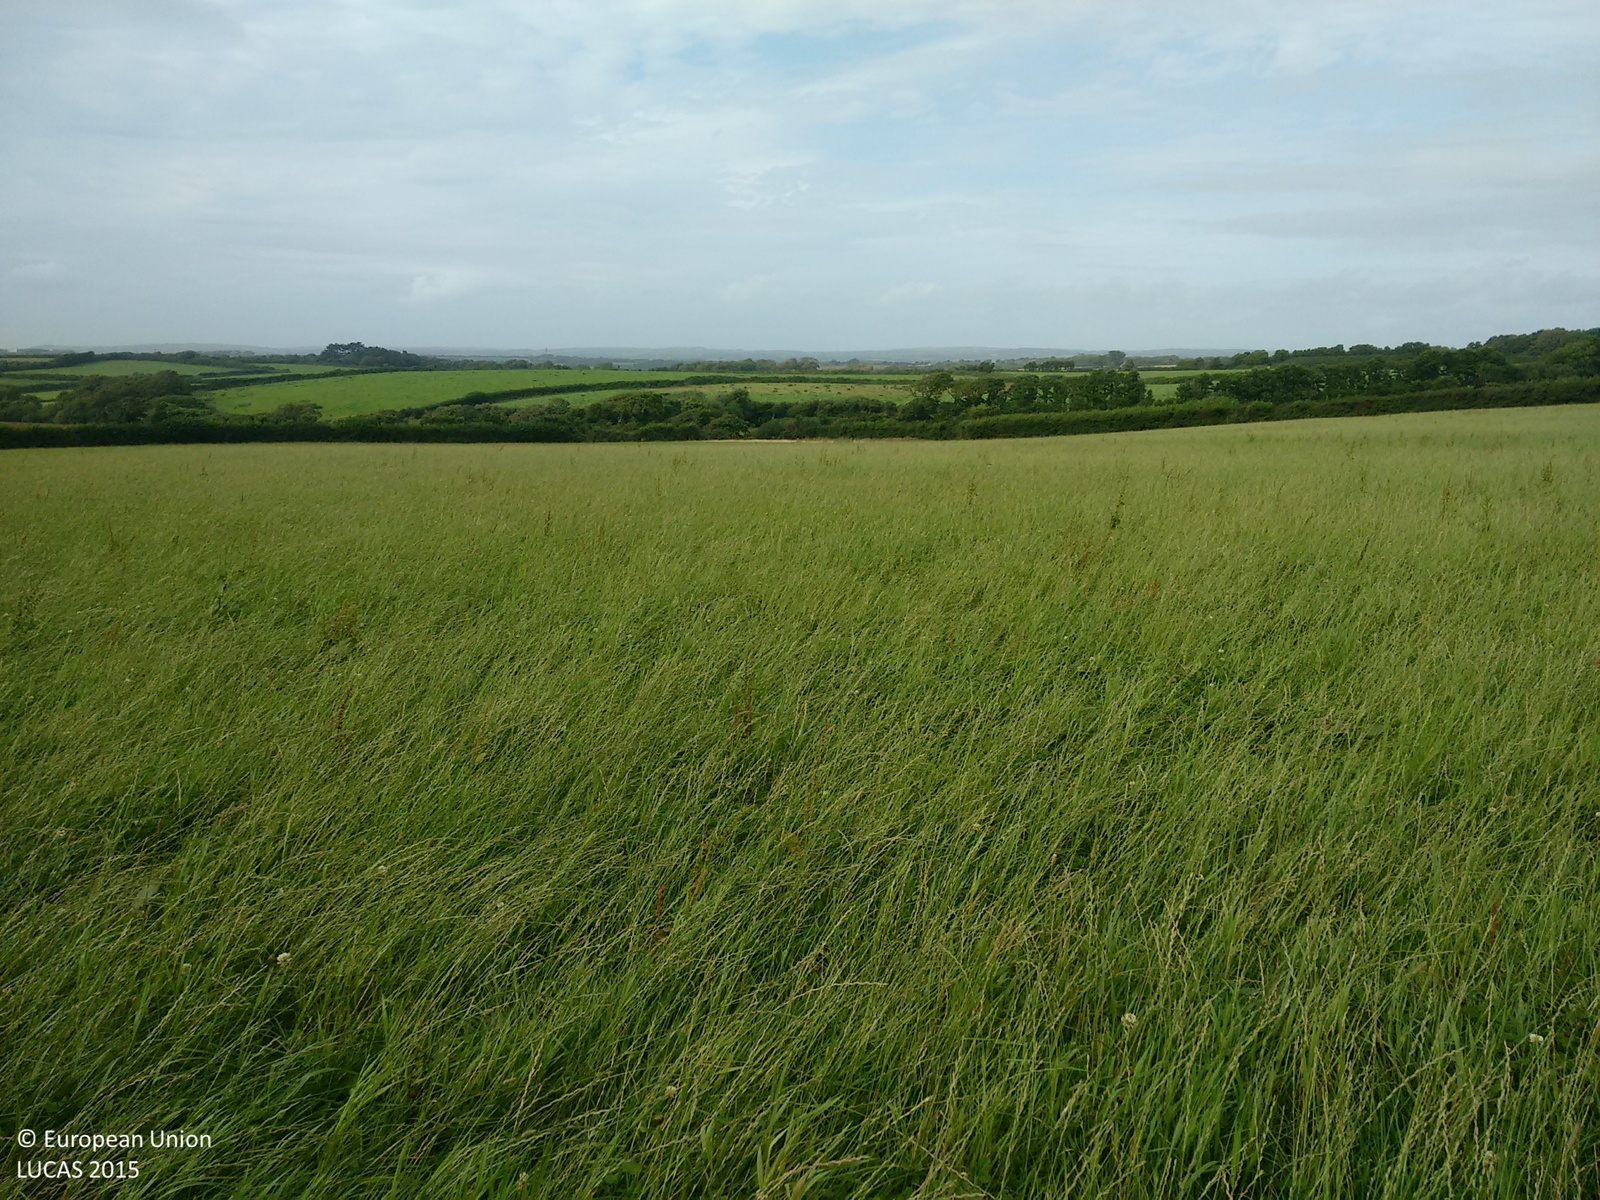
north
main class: Grassland
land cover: Grassland without tree/shrub cover
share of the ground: > 75 %
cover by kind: herbaceous plants 100 %
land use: Agriculture (excluding fallow land and kitchen gardens)
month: August
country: GB
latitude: 50.0517
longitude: -5.2178
